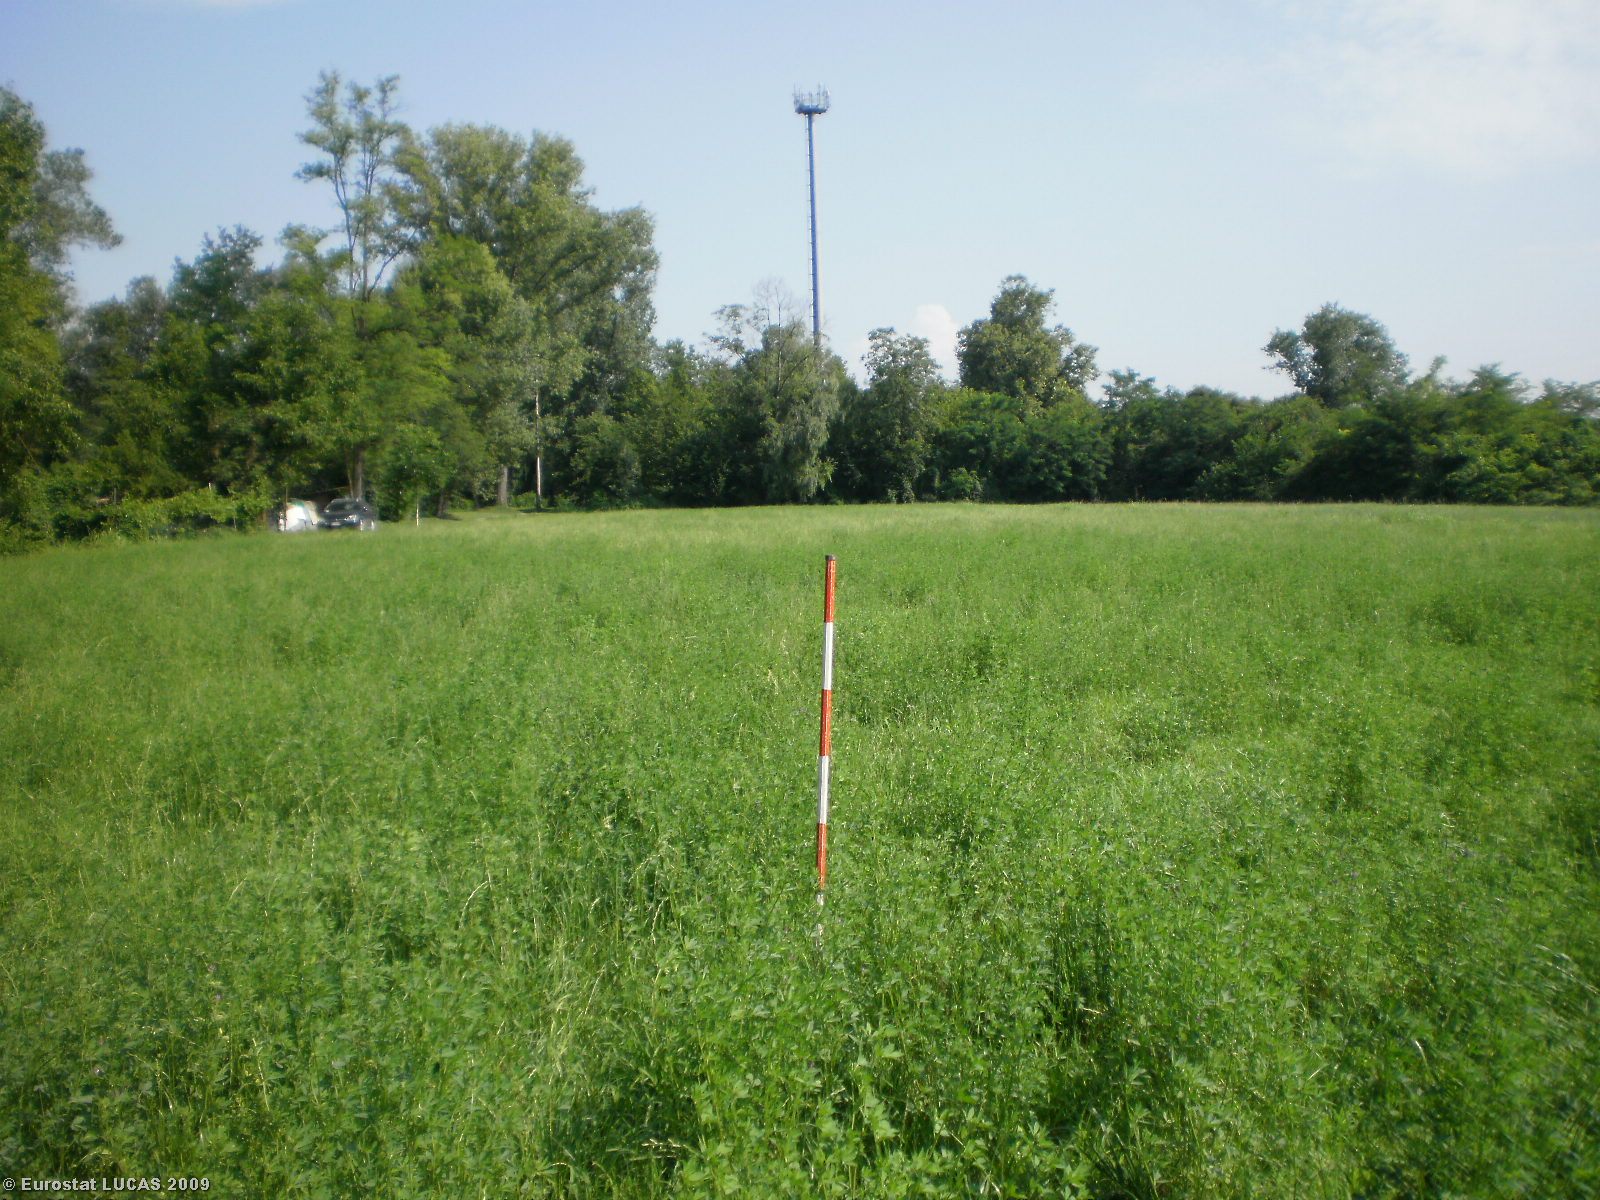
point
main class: Cropland
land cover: Lucerne
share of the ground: > 75 %
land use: Agriculture (excluding fallow land and kitchen gardens)
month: July
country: IT
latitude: 45.4672
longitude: 9.5020
